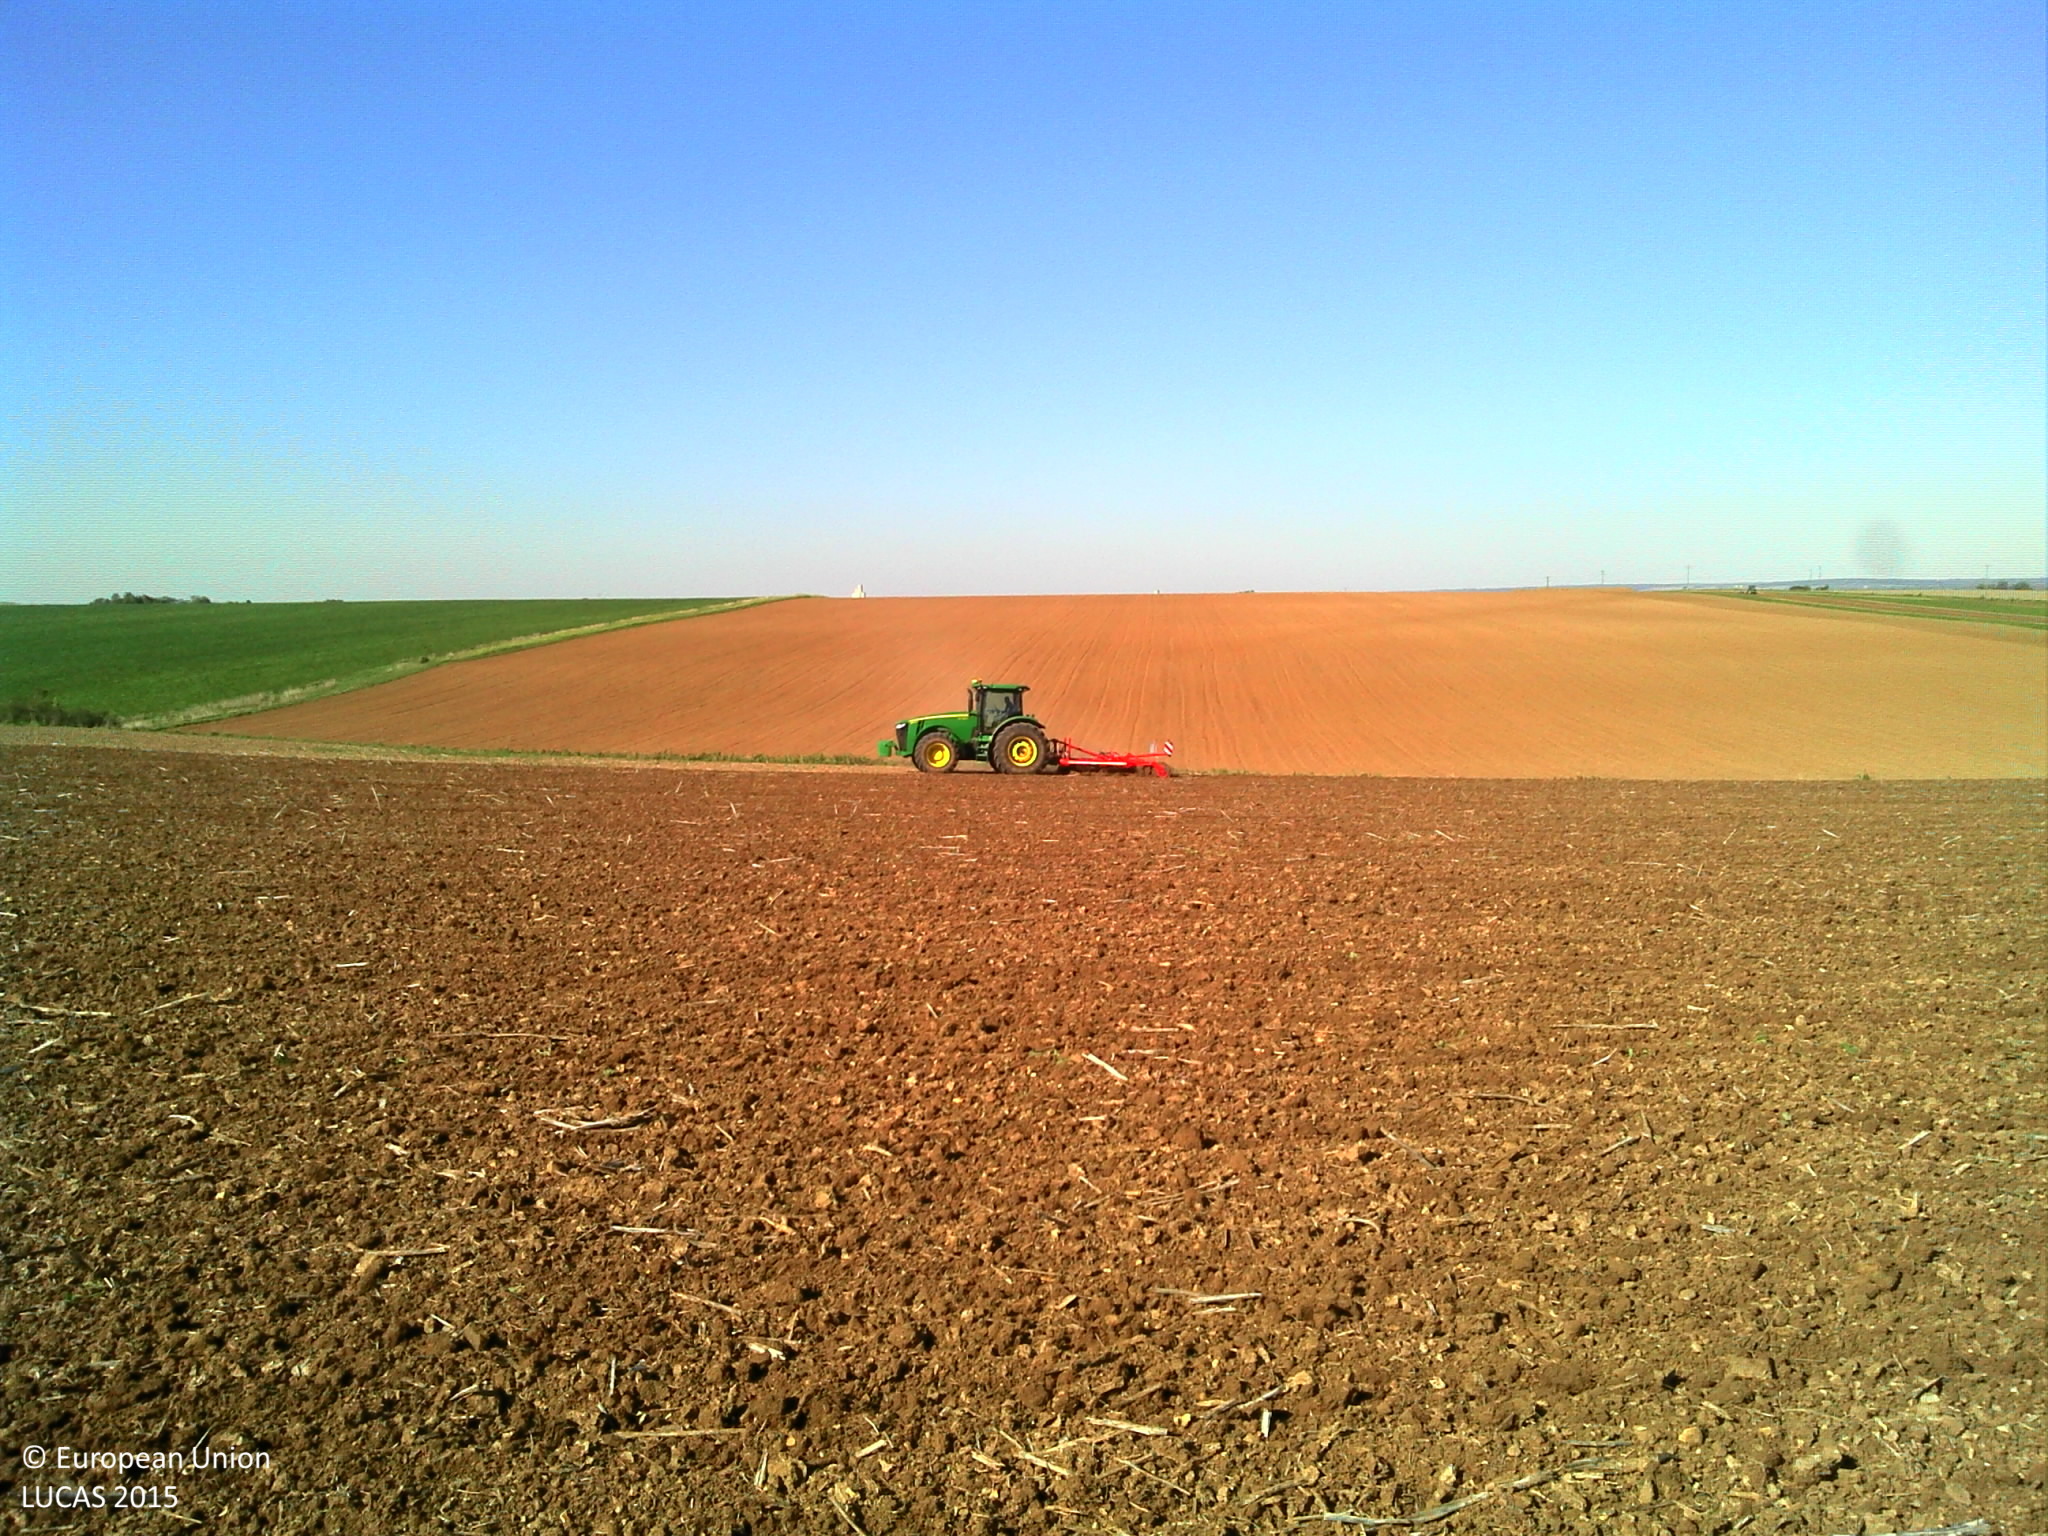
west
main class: Cropland
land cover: Rape and turnip rape
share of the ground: < 10 %
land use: Agriculture (excluding fallow land and kitchen gardens)
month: September
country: FR
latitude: 48.4025
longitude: 3.3613
